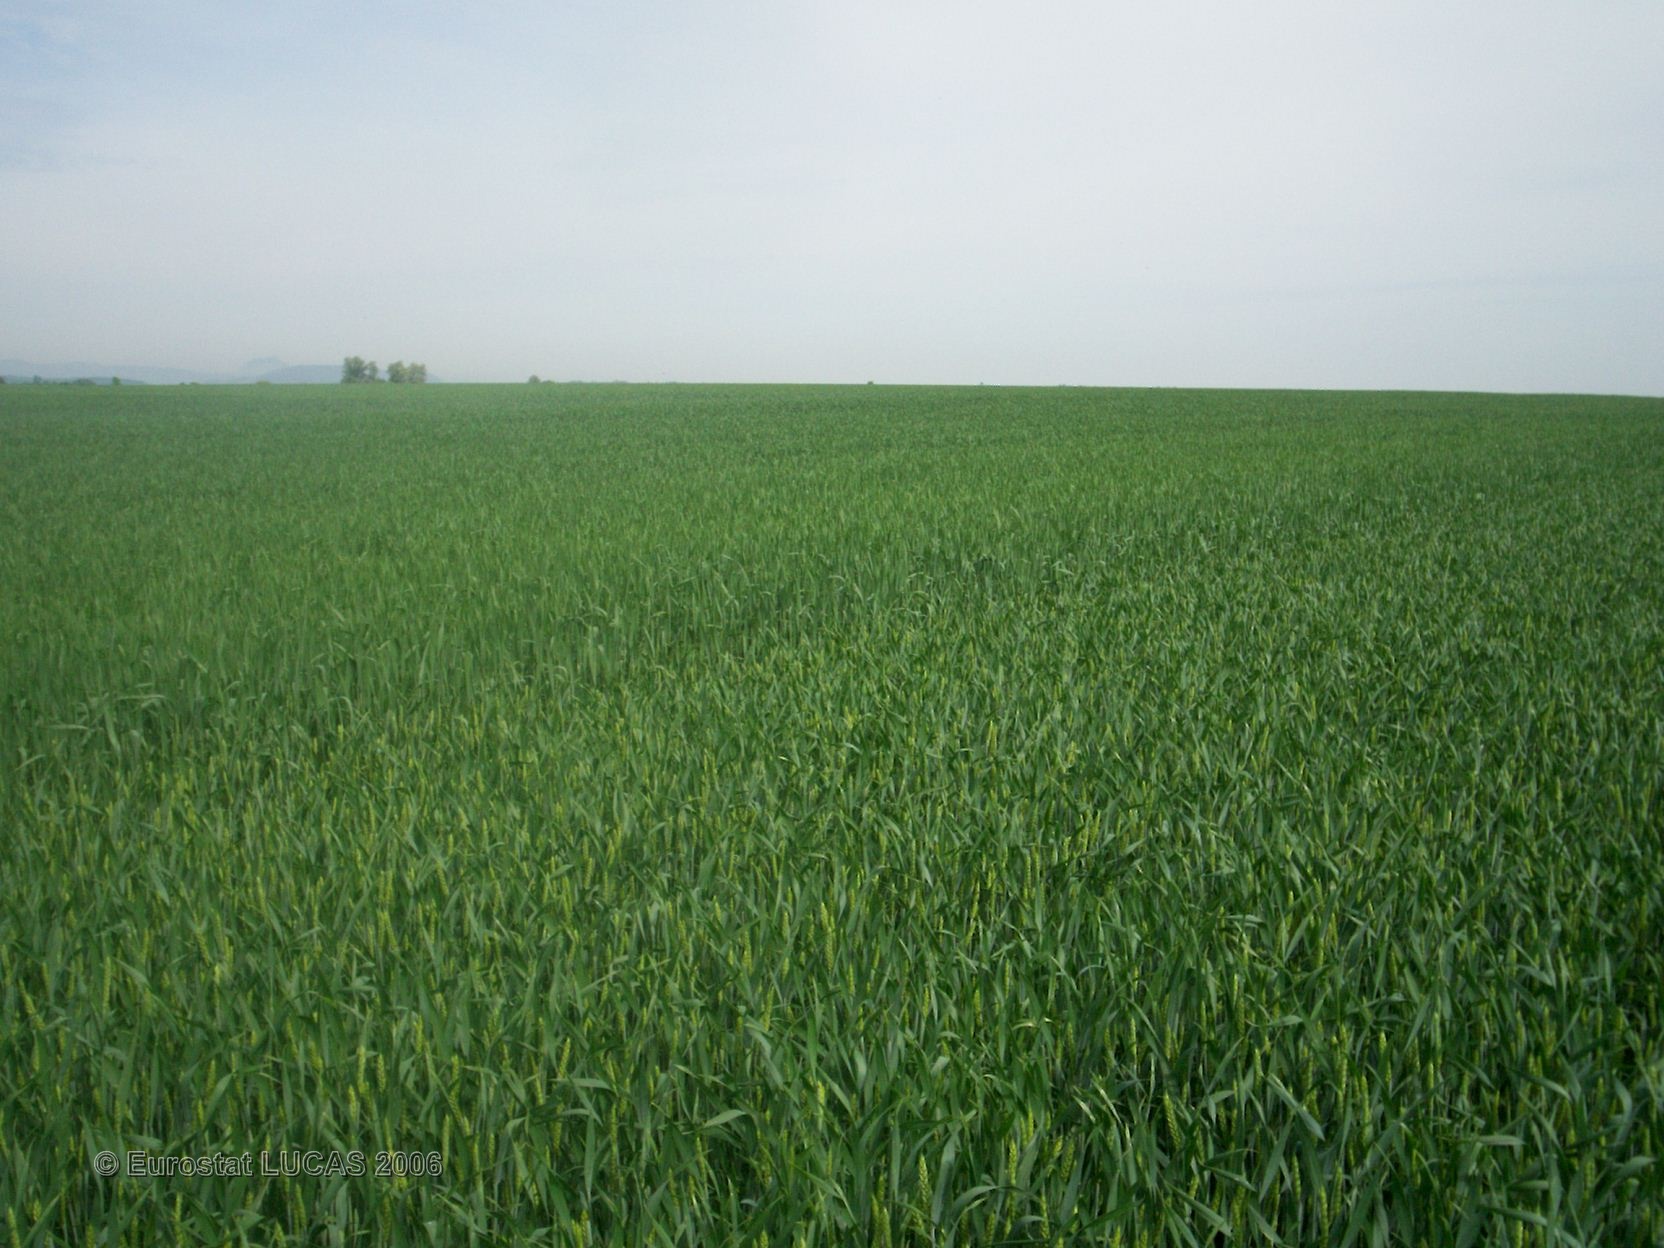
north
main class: Cropland
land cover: Common wheat
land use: Agriculture (excluding fallow land and kitchen gardens)
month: May
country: FR
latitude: 45.5203
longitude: 3.2029
